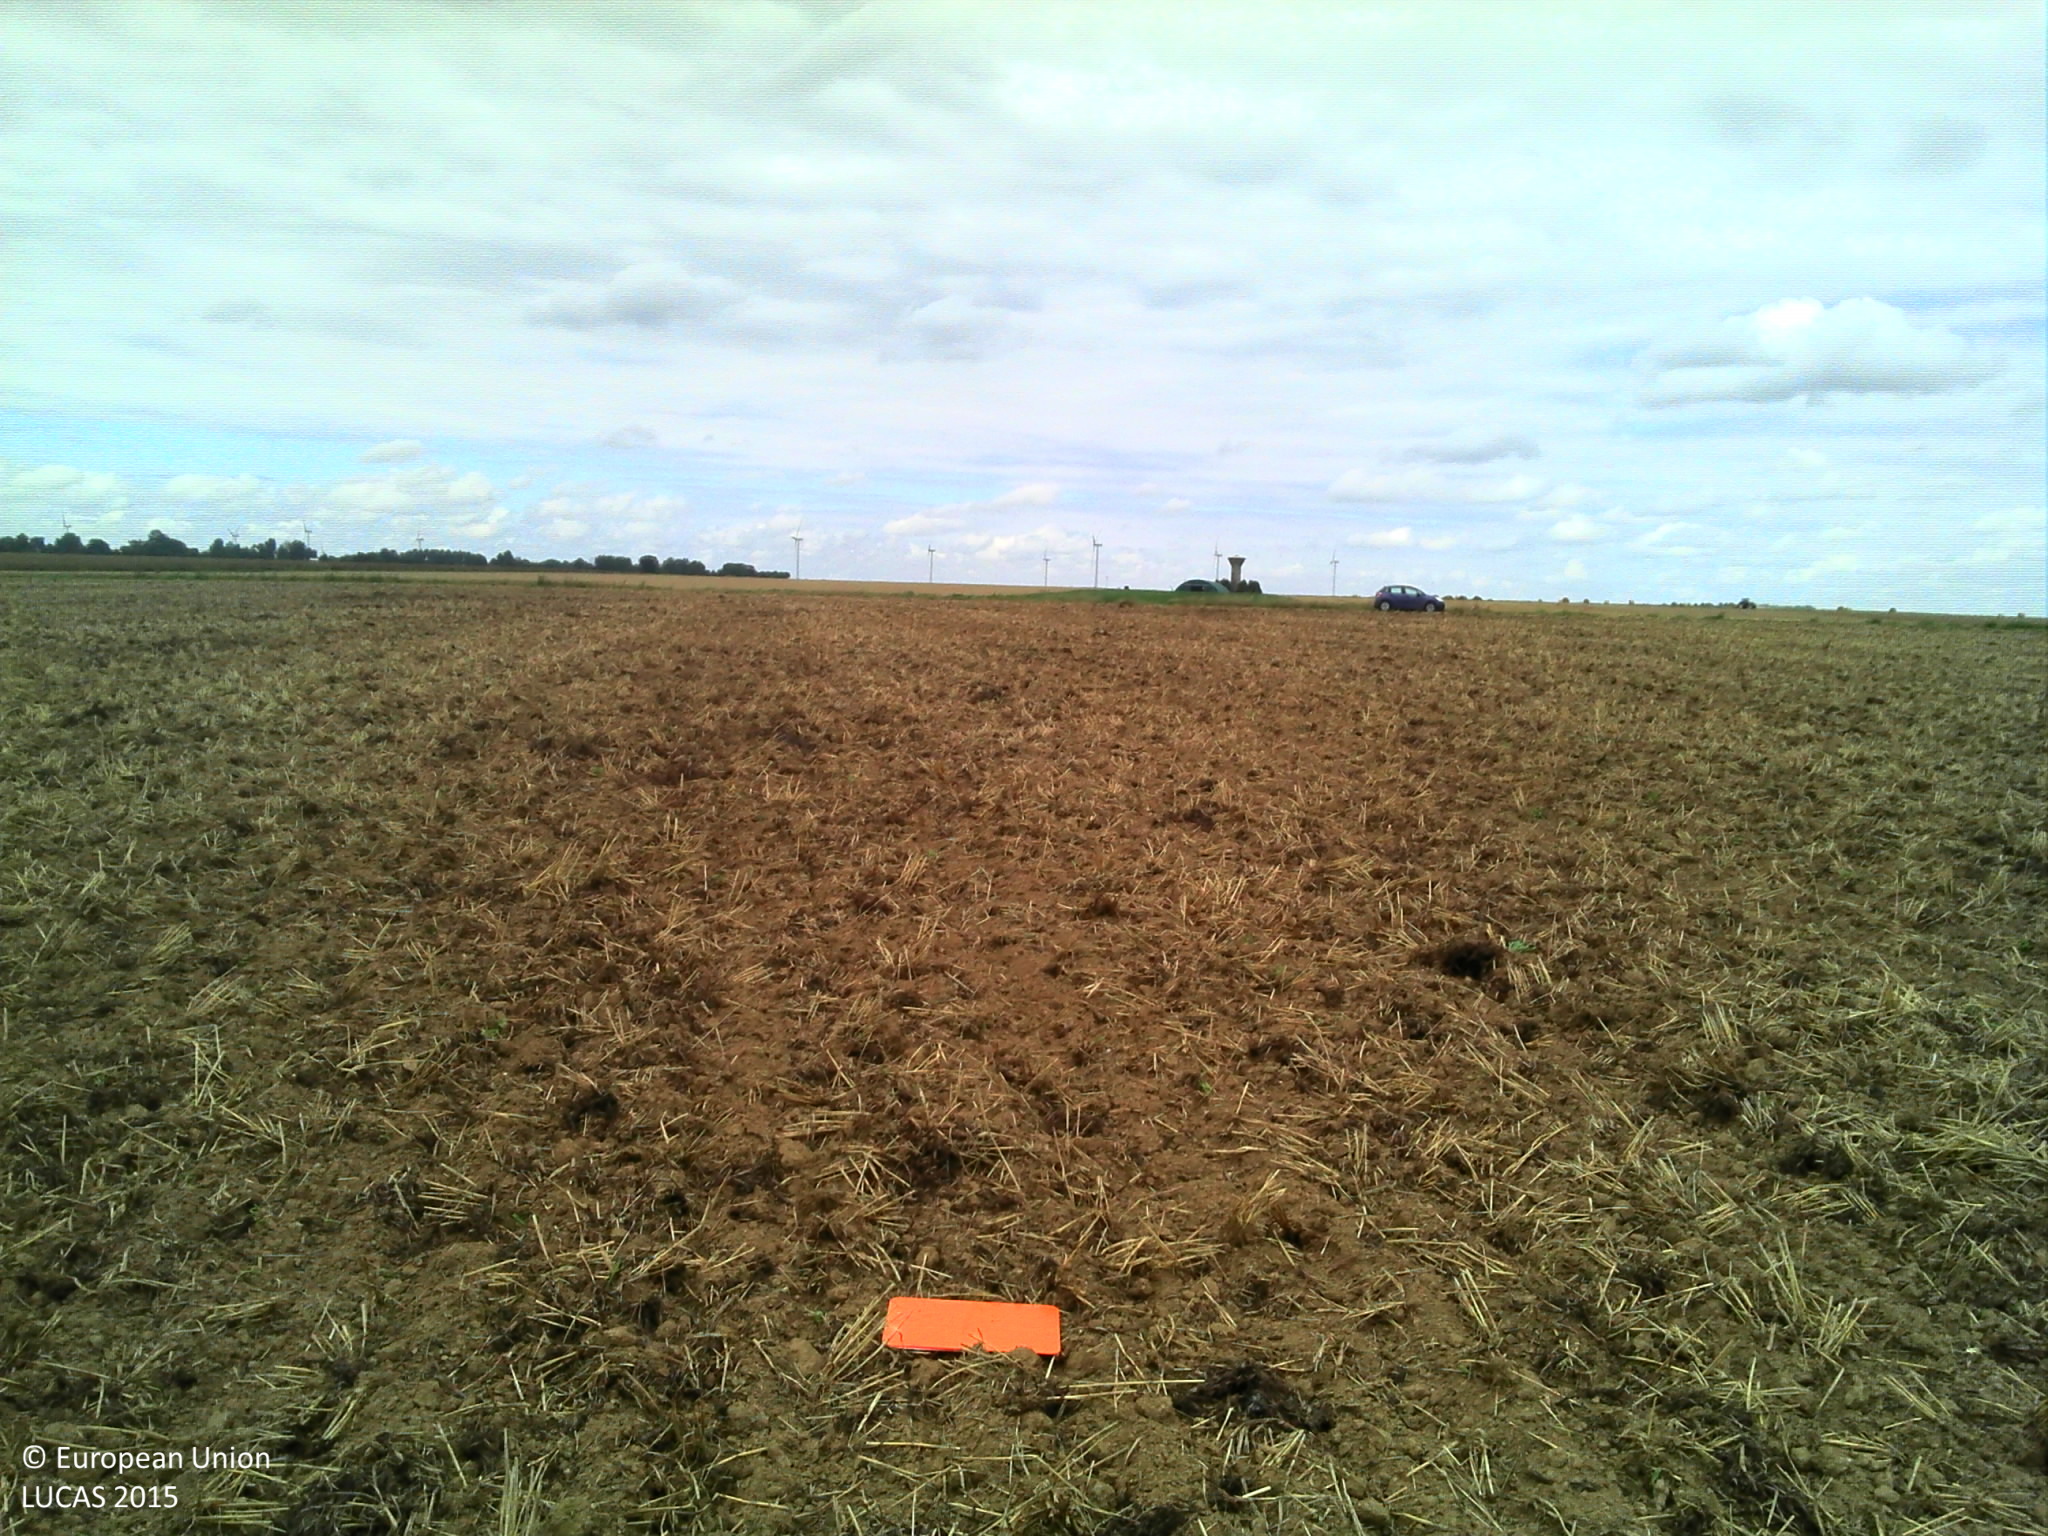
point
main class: Cropland
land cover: Barley
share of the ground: 10 - 25 %
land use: Agriculture (excluding fallow land and kitchen gardens)
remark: Harvested field
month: July
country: FR
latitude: 50.1293
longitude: 2.1376
